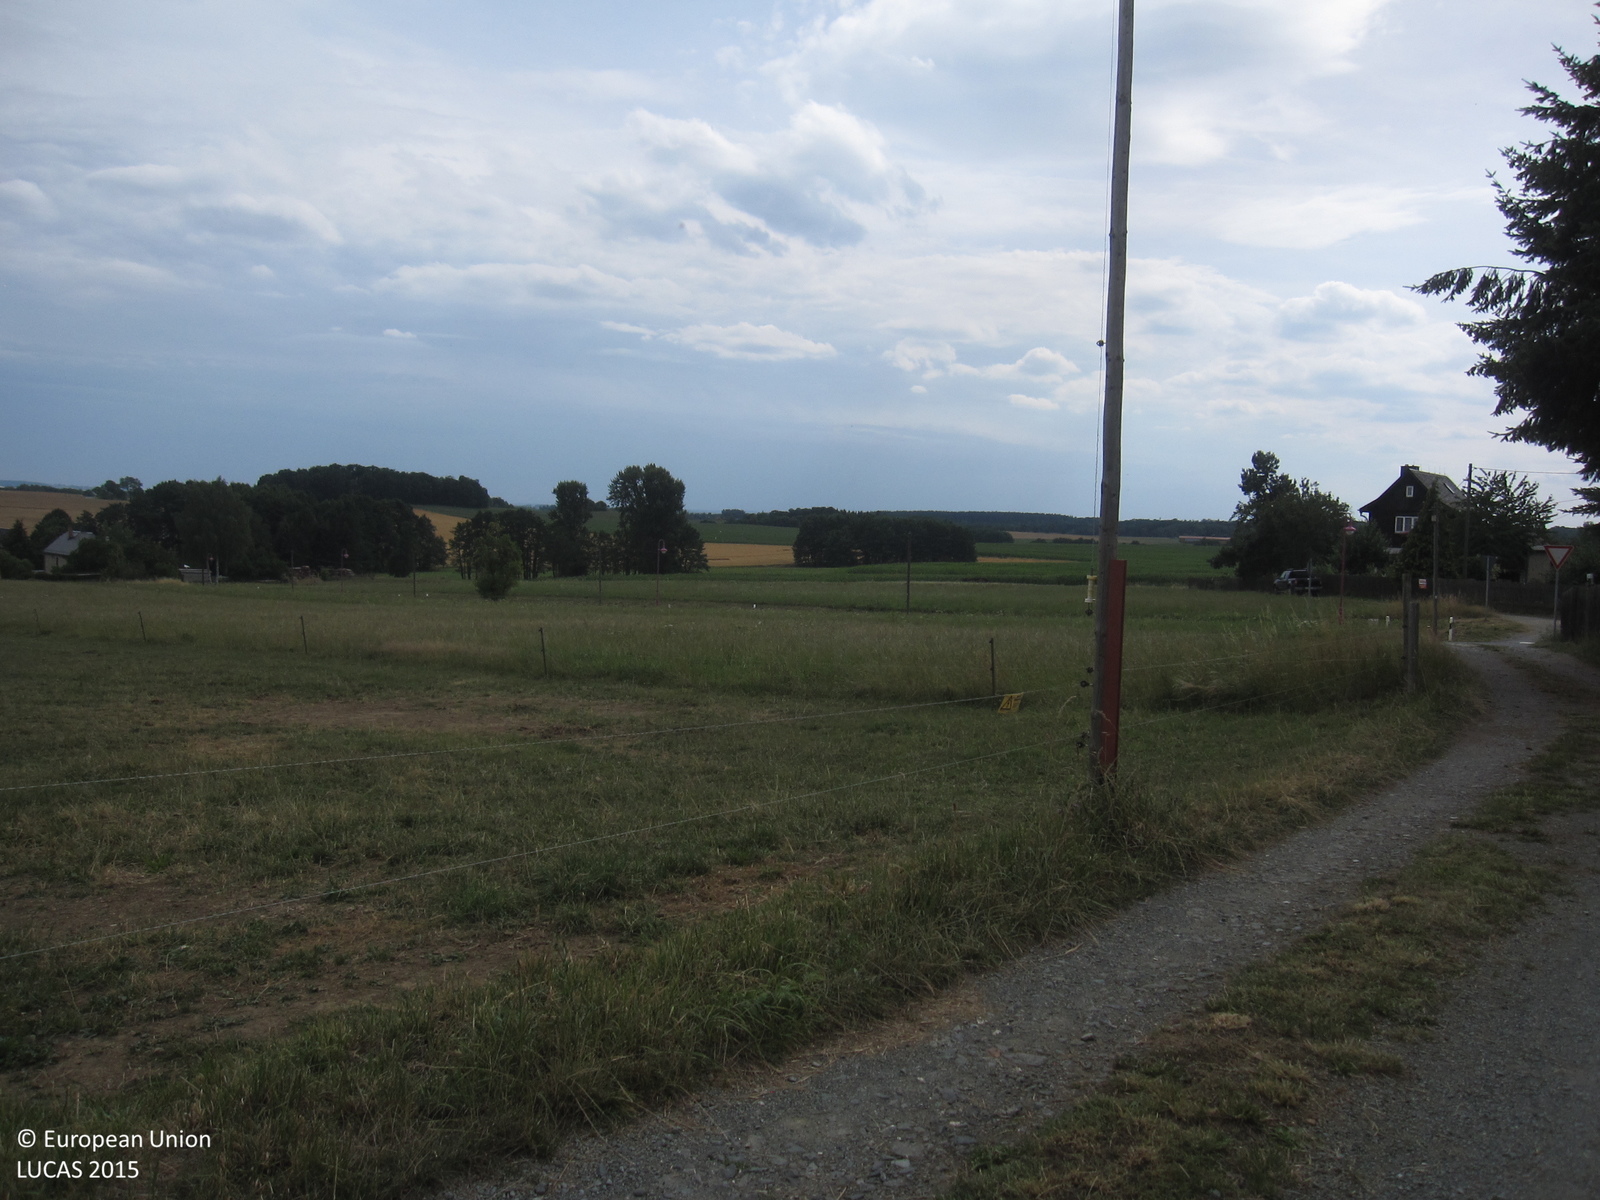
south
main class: Woodland
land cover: Broadleaved woodland
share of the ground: 25 - 50 %
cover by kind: herbaceous plants 65 %, broadleaved forest trees 35 %
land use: Residential
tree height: > 5 m
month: August
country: DE
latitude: 50.5601
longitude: 12.1312
